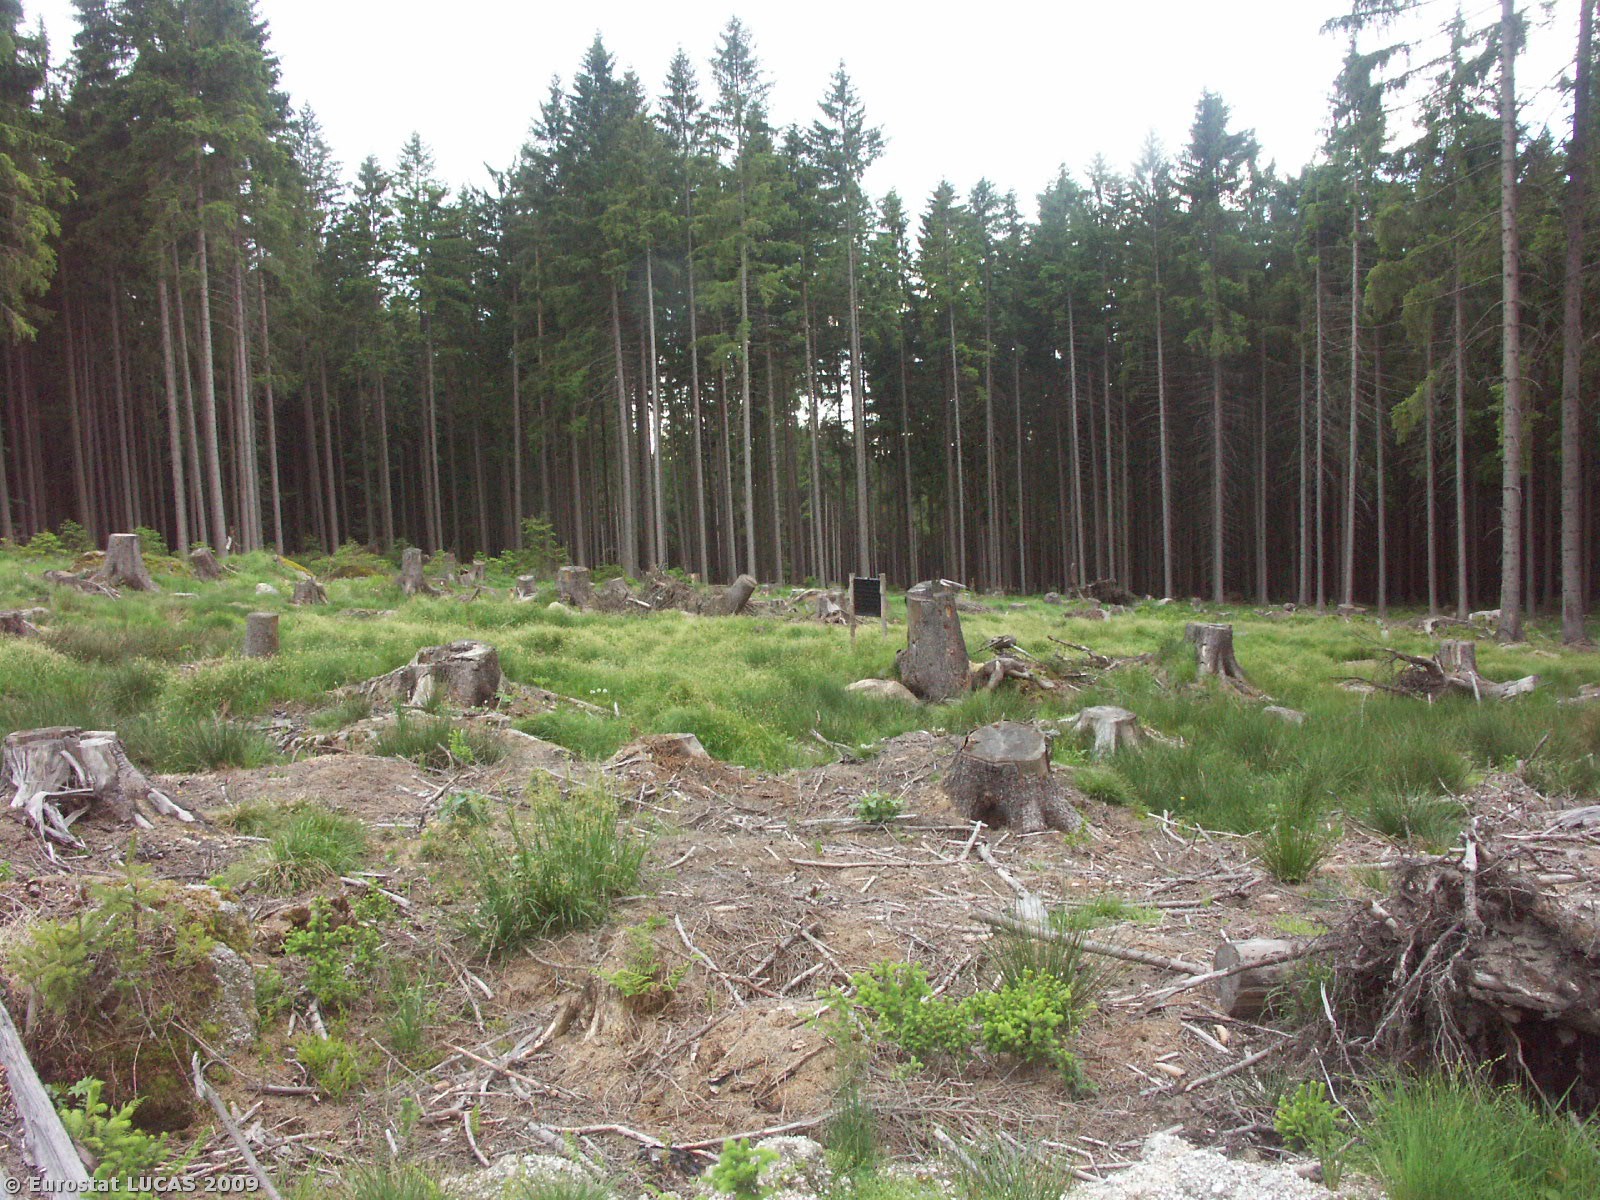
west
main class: Woodland
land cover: Coniferous woodland
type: hemiboreal forest and nemoral coniferous forest and mixed broadleaved-coniferous forest
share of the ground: 10 - 25 %
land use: Forestry
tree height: > 5 m
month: May
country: CZ
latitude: 48.7197
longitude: 14.6634
